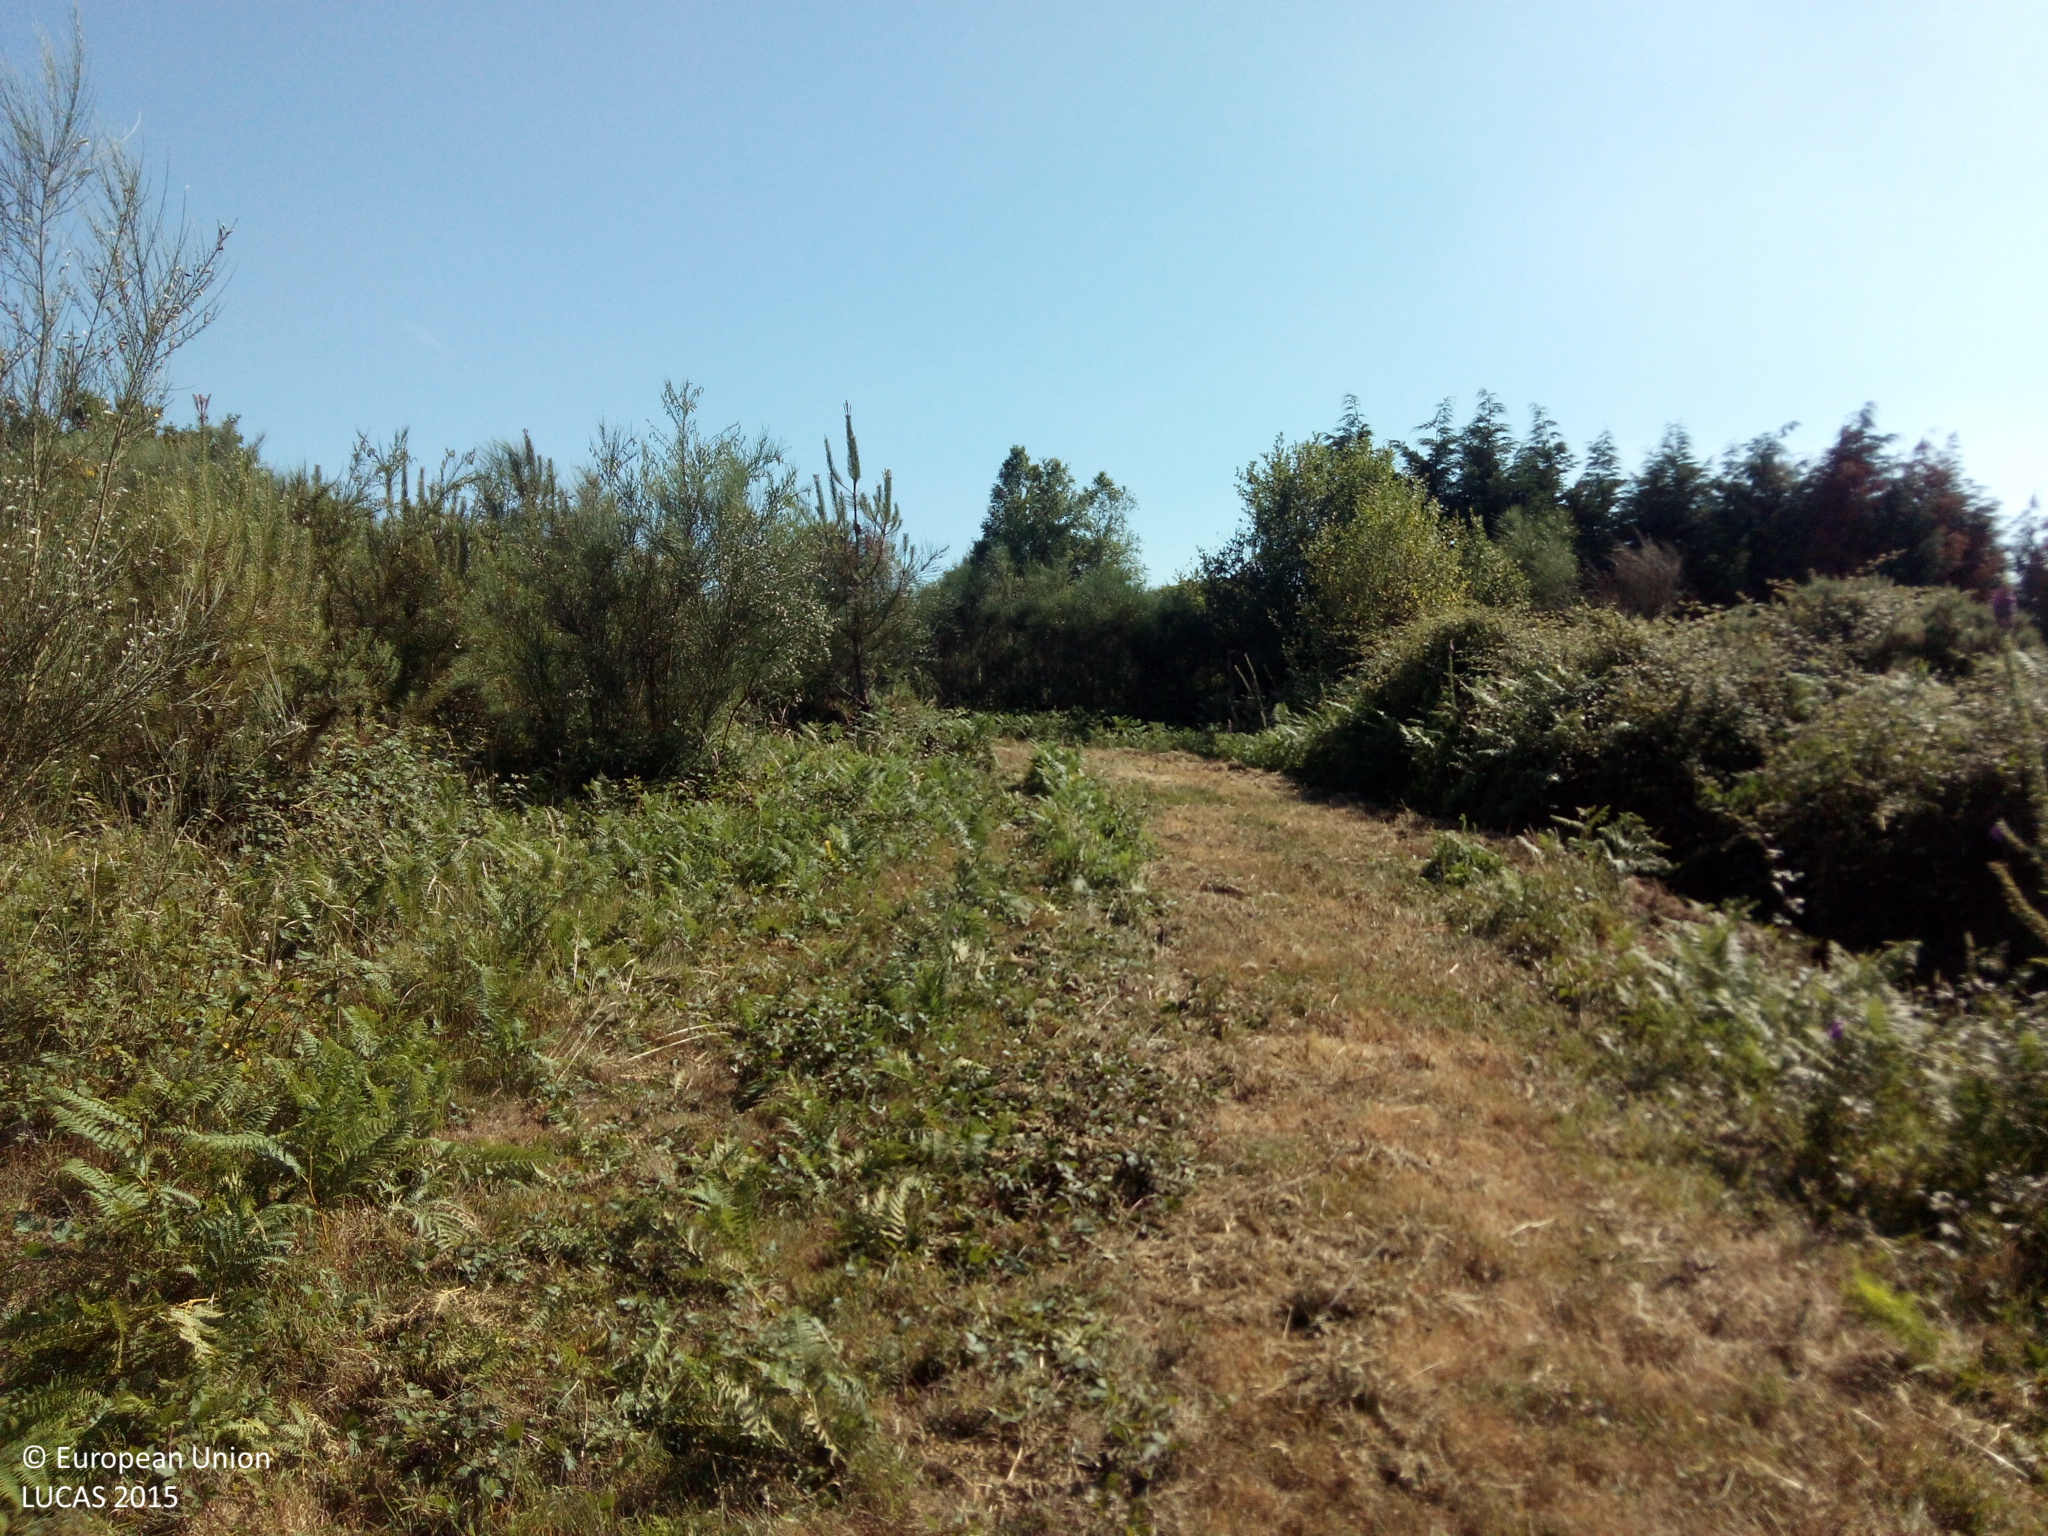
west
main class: Woodland
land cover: Pine dominated coniferous woodland
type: hemiboreal forest and nemoral coniferous forest and mixed broadleaved-coniferous forest
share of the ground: 25 - 50 %
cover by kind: coniferous forest trees 50 %, shrubs 30 %, herbaceous plants 20 %
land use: Forestry
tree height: < 5 m
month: June
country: ES
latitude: 42.9939
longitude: -8.0352
